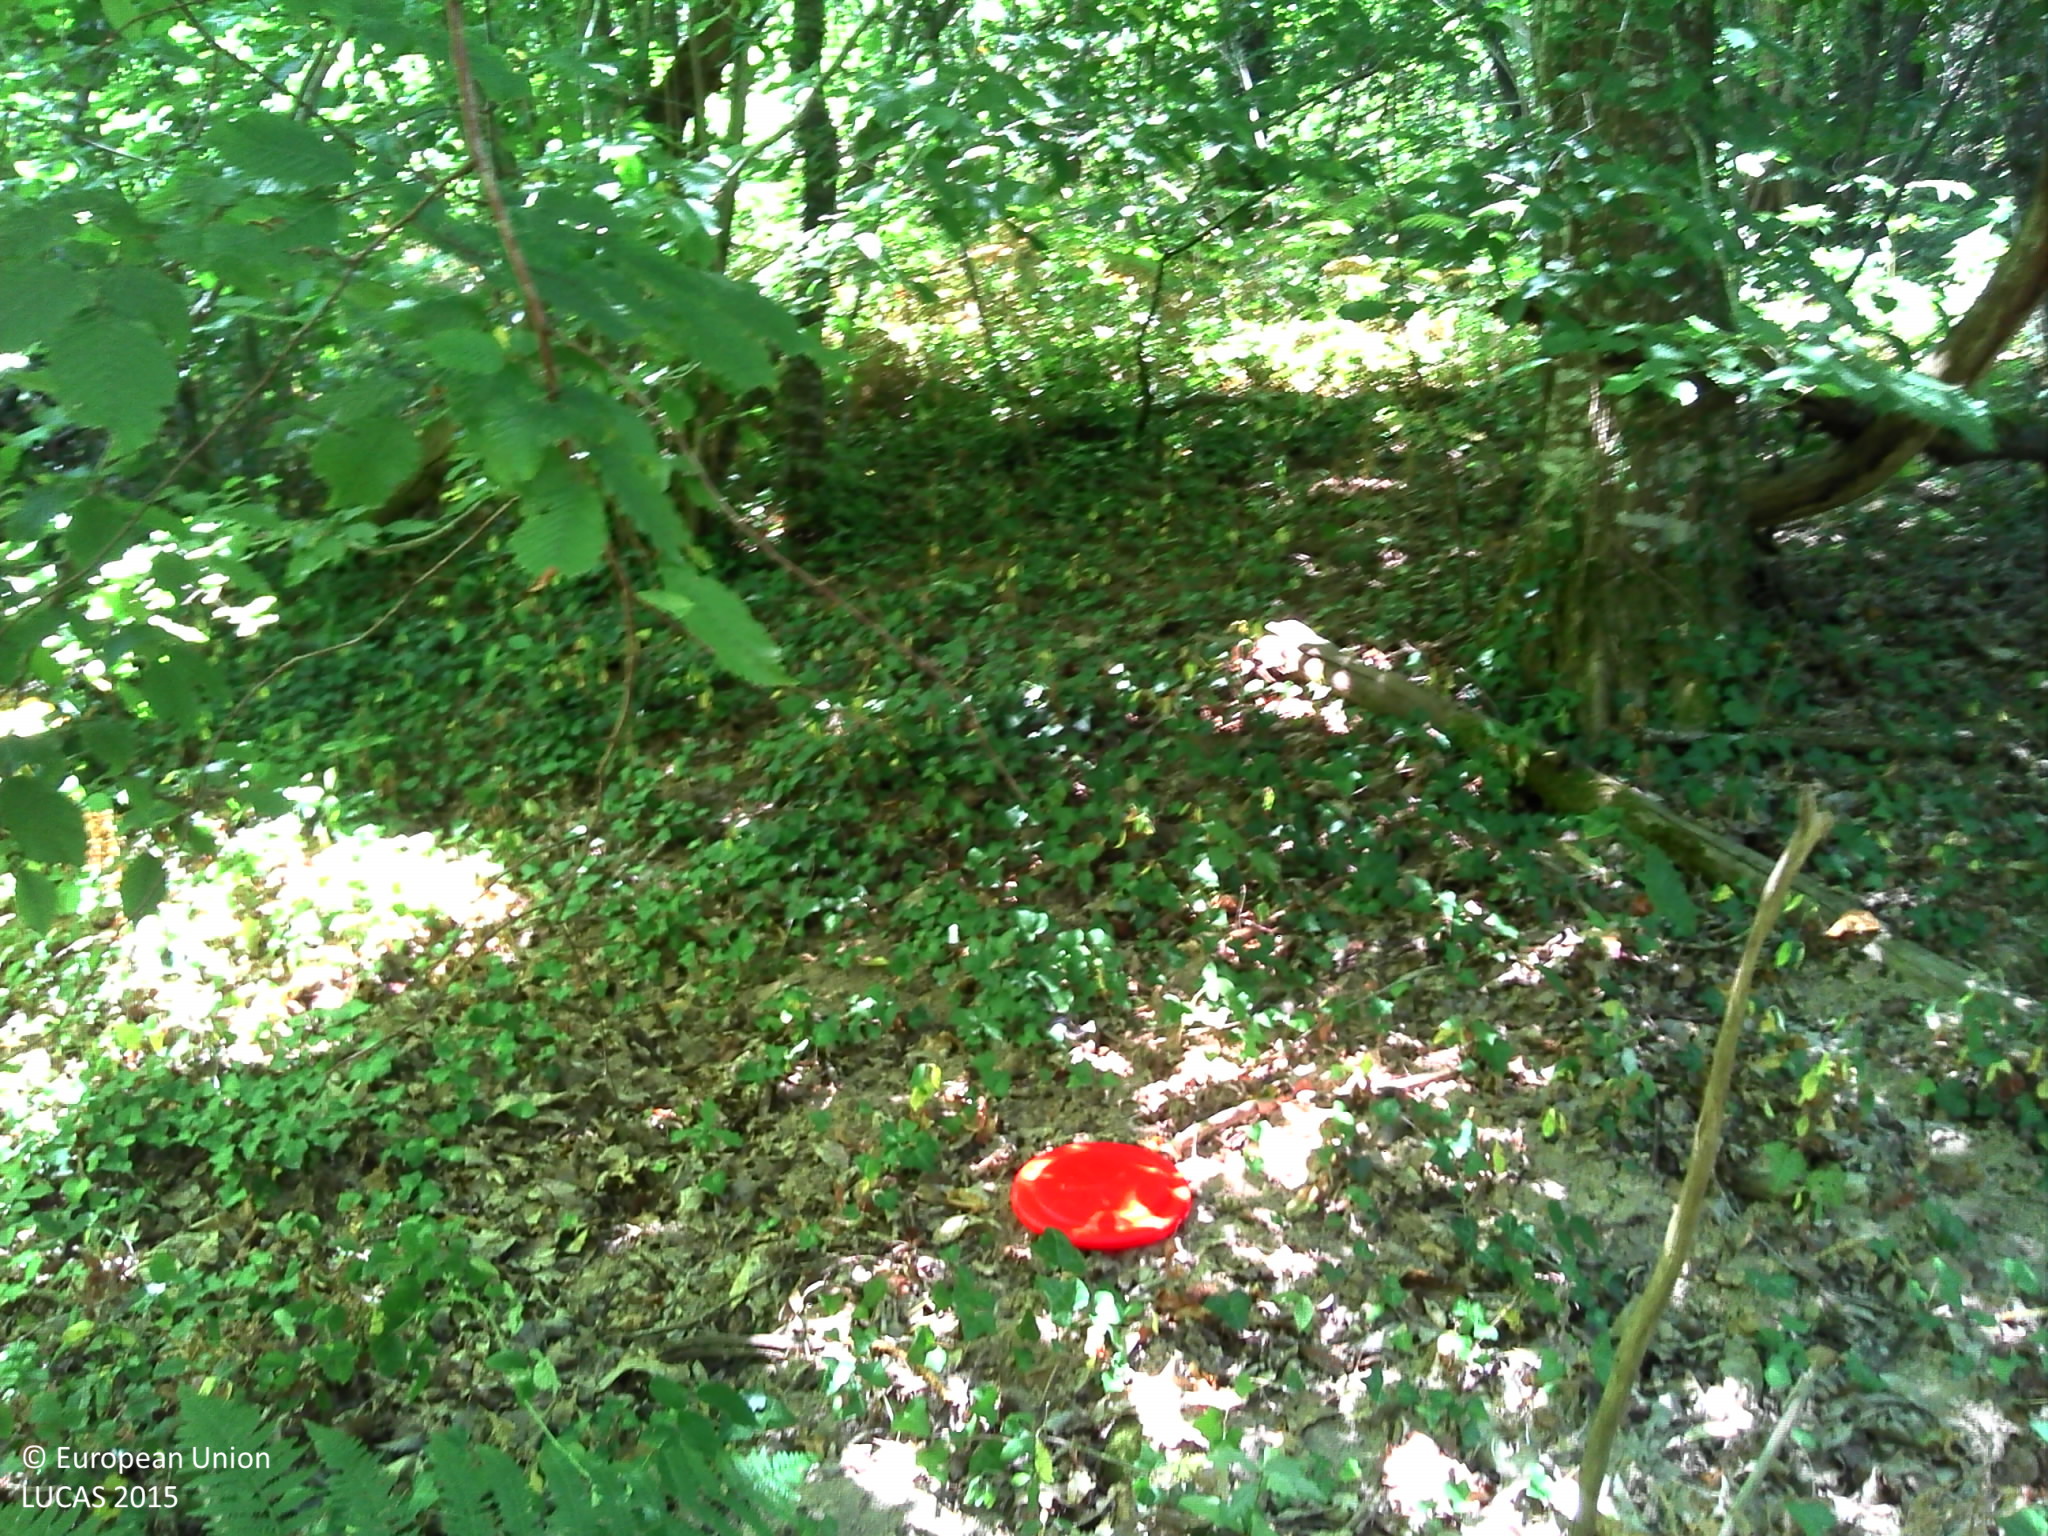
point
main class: Woodland
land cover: Broadleaved woodland
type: beech forest
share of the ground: > 75 %
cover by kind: broadleaved forest trees 80 %, herbaceous plants 10 %, shrubs 5 %, lichens and mosses 5 %
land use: Forestry
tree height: > 5 m
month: July
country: FR
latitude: 44.8966
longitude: 0.5309
